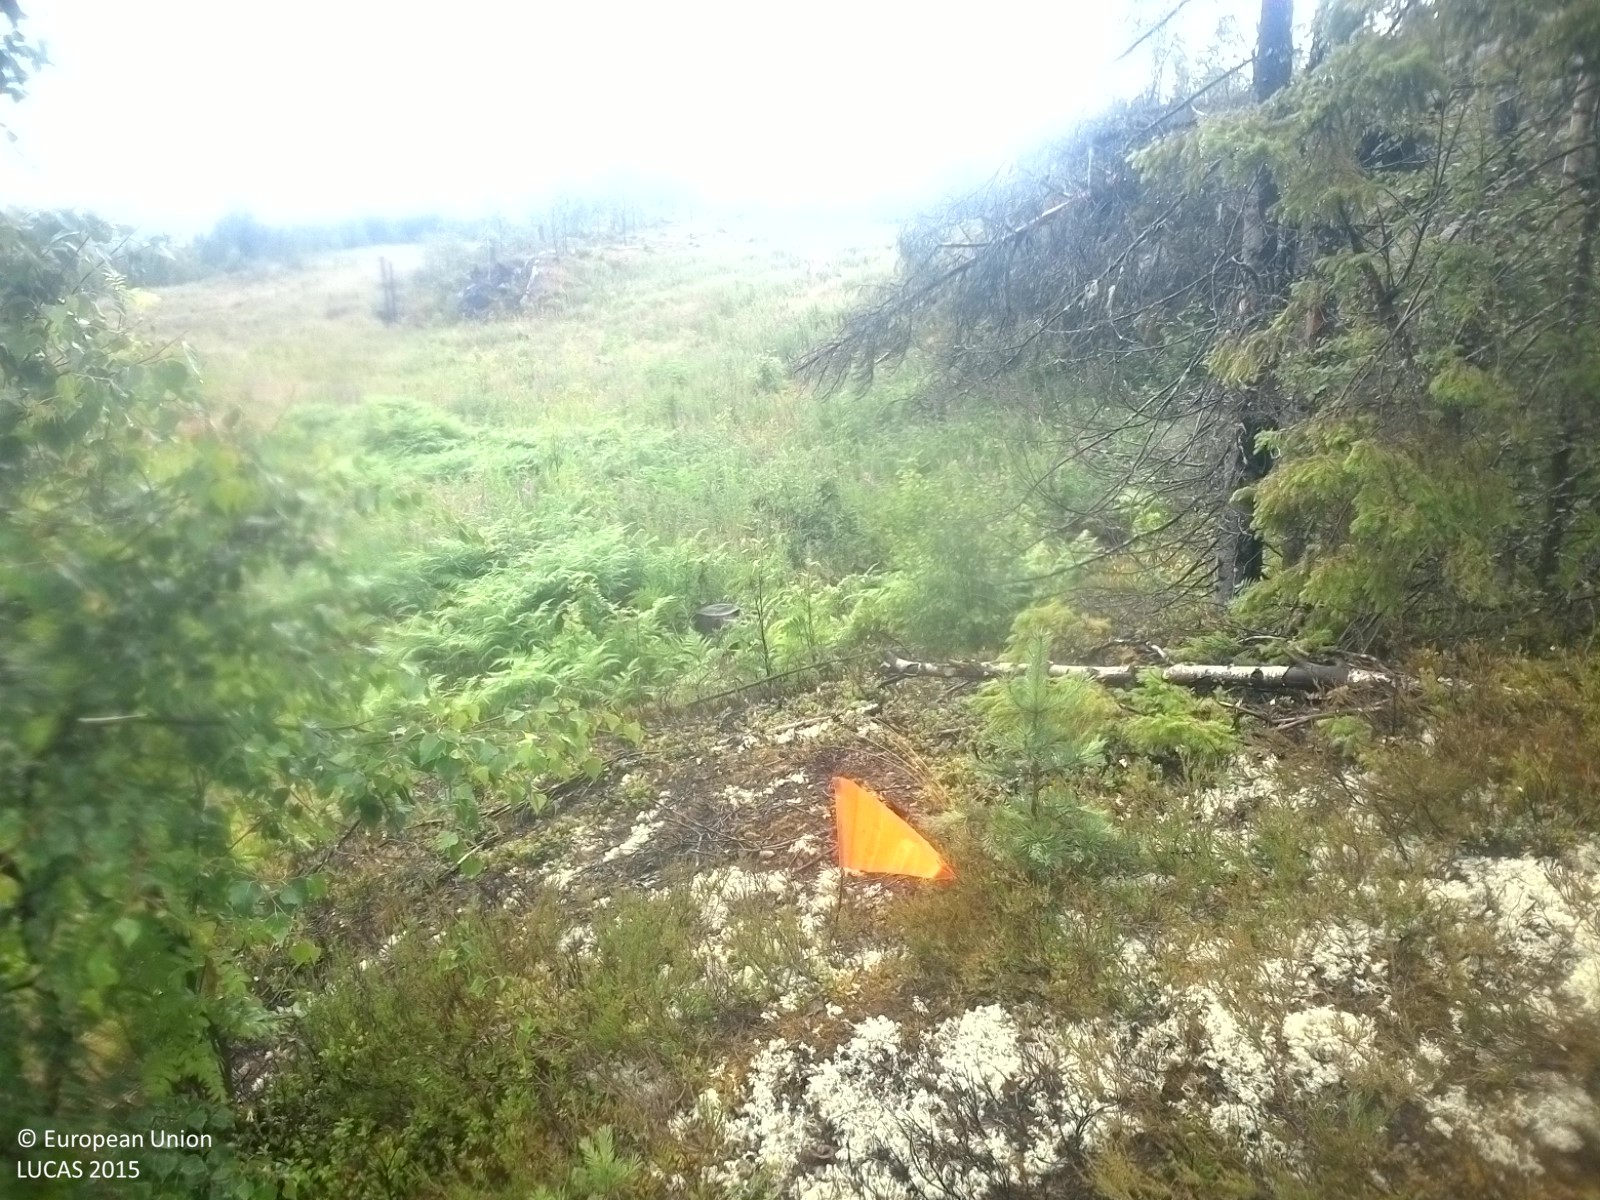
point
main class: Woodland
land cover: Other mixed woodland
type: boreal forest
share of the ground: 25 - 50 %
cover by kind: broadleaved forest trees 25 %, herbaceous plants 25 %, shrubs 20 %, lichens and mosses 20 %, coniferous forest trees 10 %
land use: Forestry
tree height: < 5 m
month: July
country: SE
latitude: 62.4112
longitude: 17.0446
